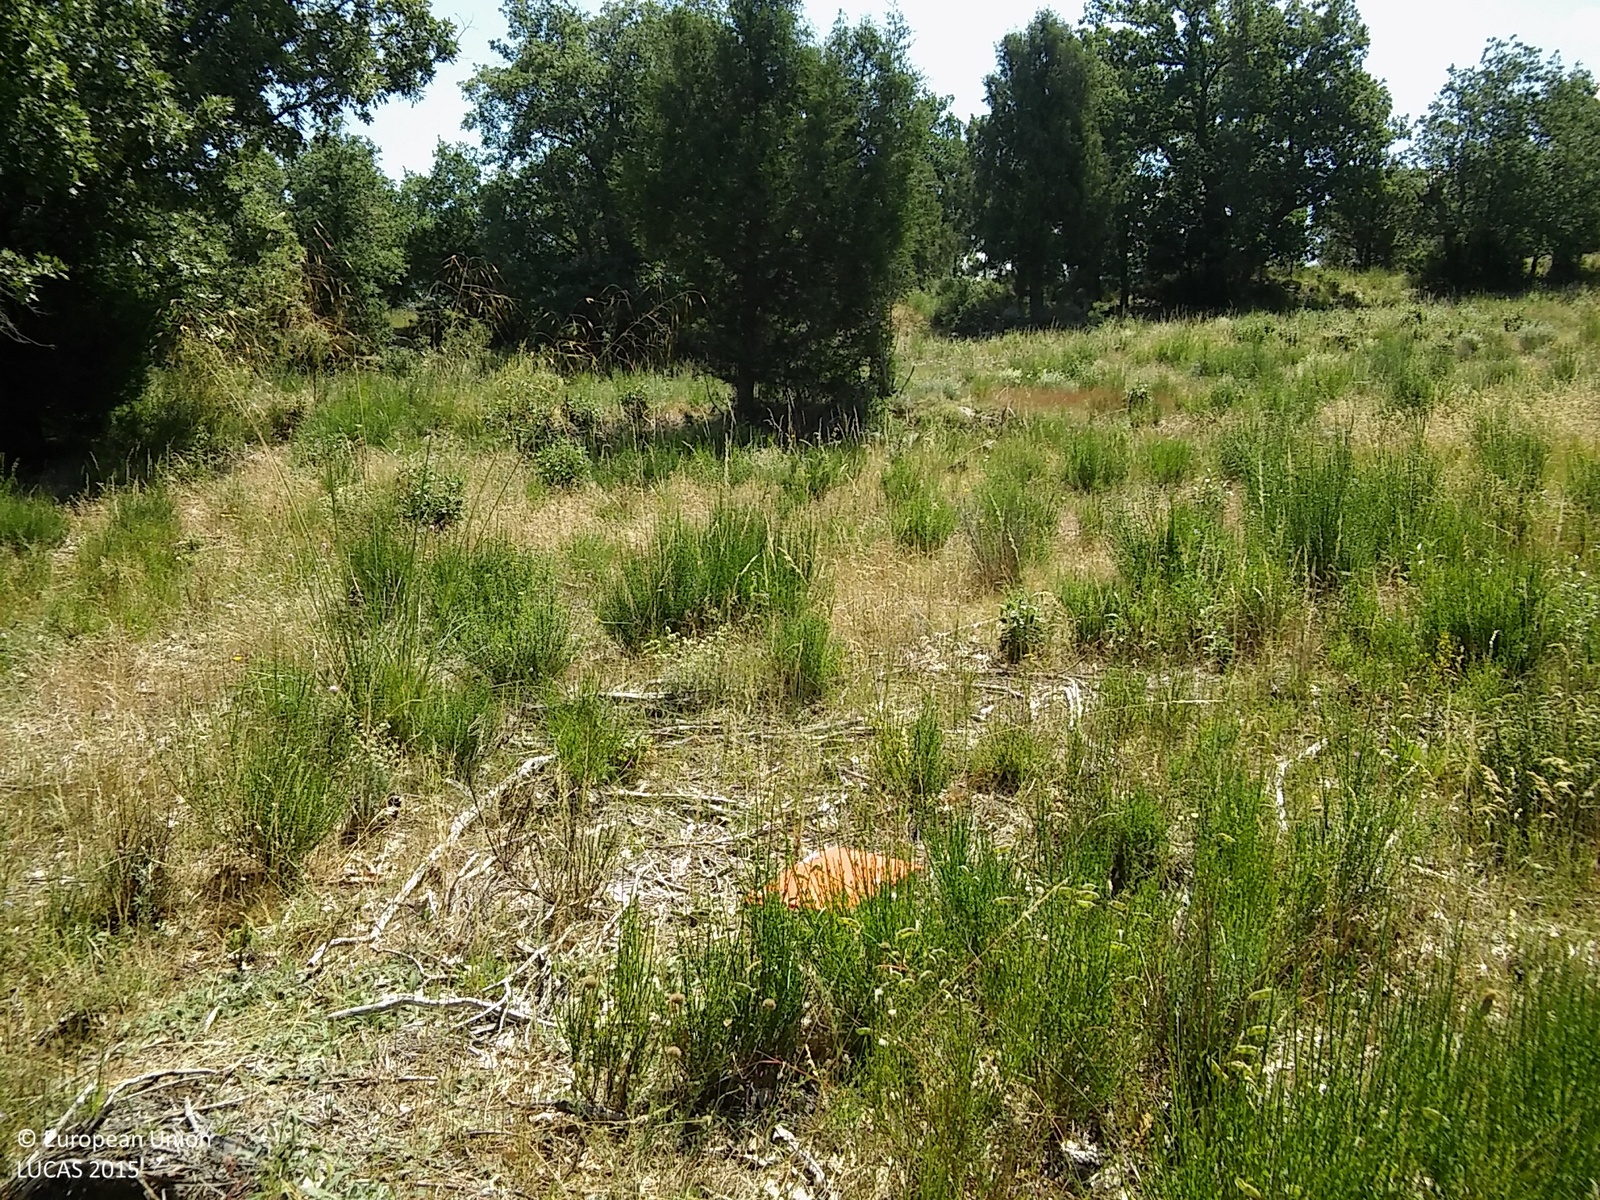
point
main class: Woodland
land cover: Other mixed woodland
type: thermophilous deciduous forest
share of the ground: 50 - 75 %
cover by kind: broadleaved forest trees 35 %, coniferous forest trees 25 %, shrubs 20 %, herbaceous plants 15 %, lichens and mosses 5 %
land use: Forestry
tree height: > 5 m
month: June
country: ES
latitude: 41.1878
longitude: -3.6983
